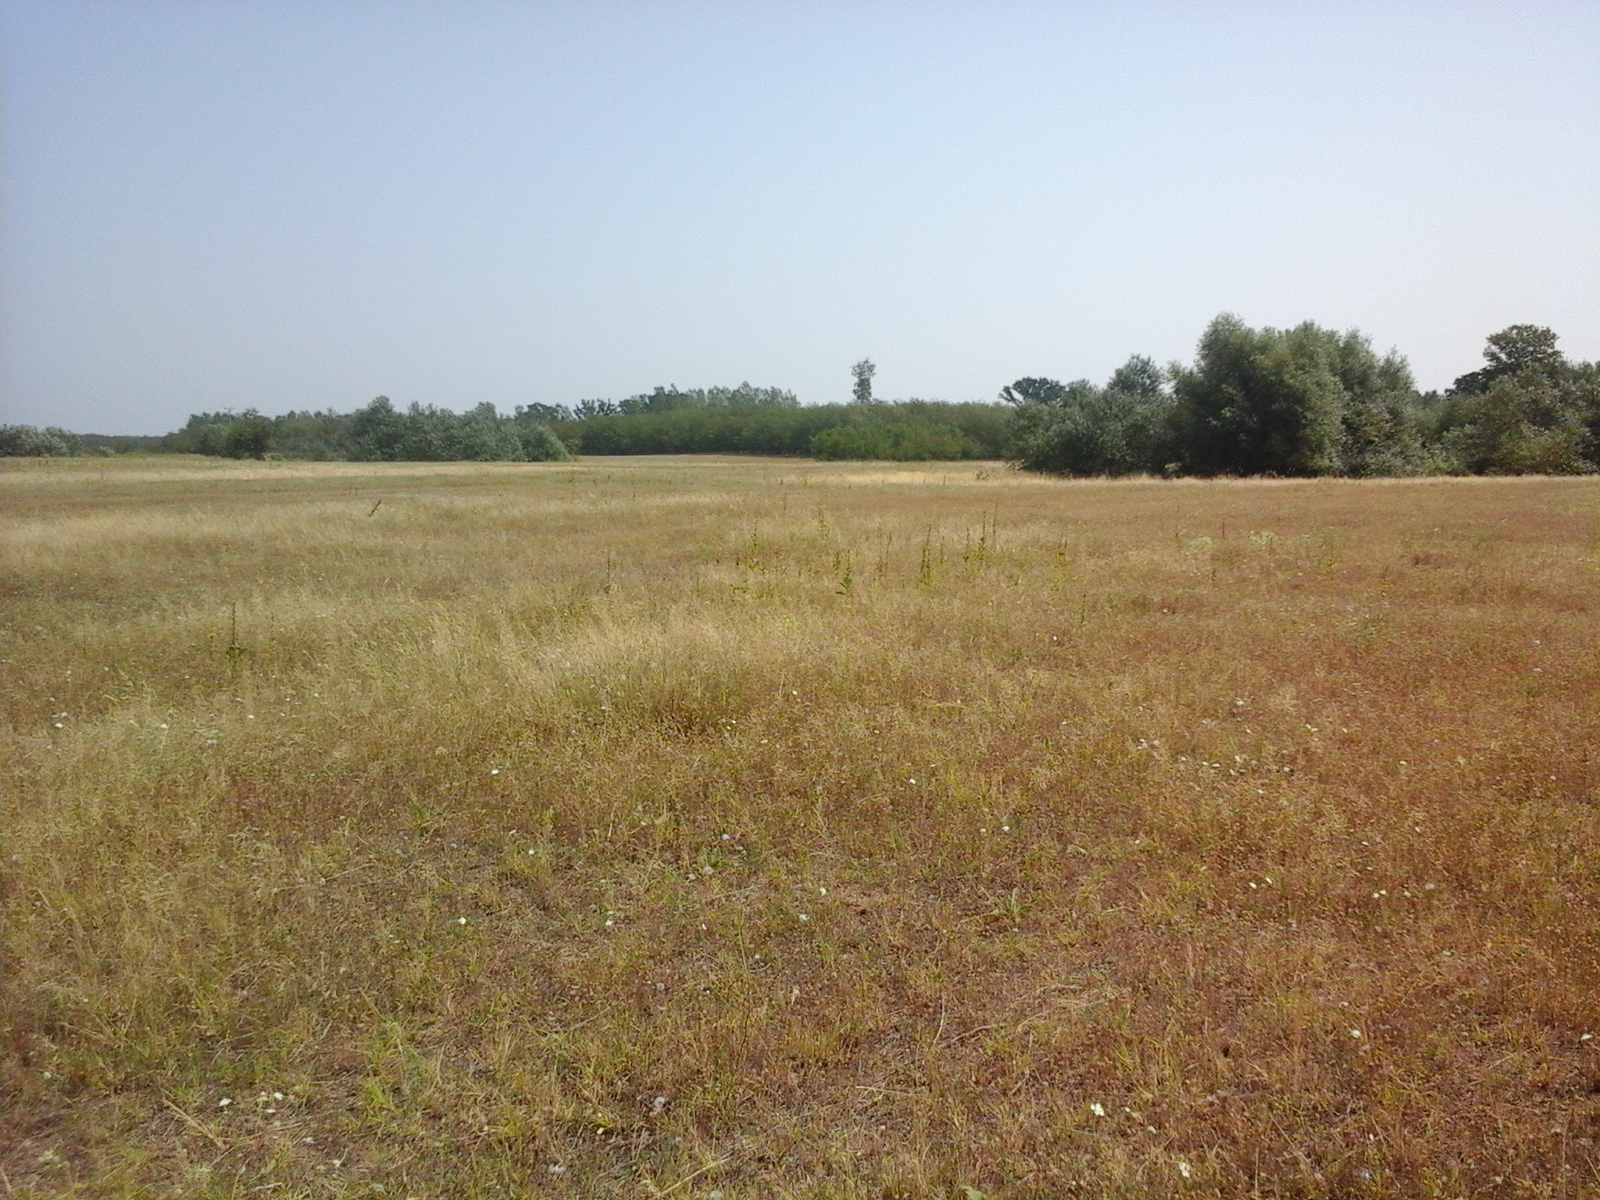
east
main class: Grassland
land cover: Grassland without tree/shrub cover
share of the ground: > 75 %
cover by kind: herbaceous plants 100 %
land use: Agriculture (excluding fallow land and kitchen gardens)
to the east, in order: Grassland without tree/shrub cover
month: August
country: RO
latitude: 44.3959
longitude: 22.6317
